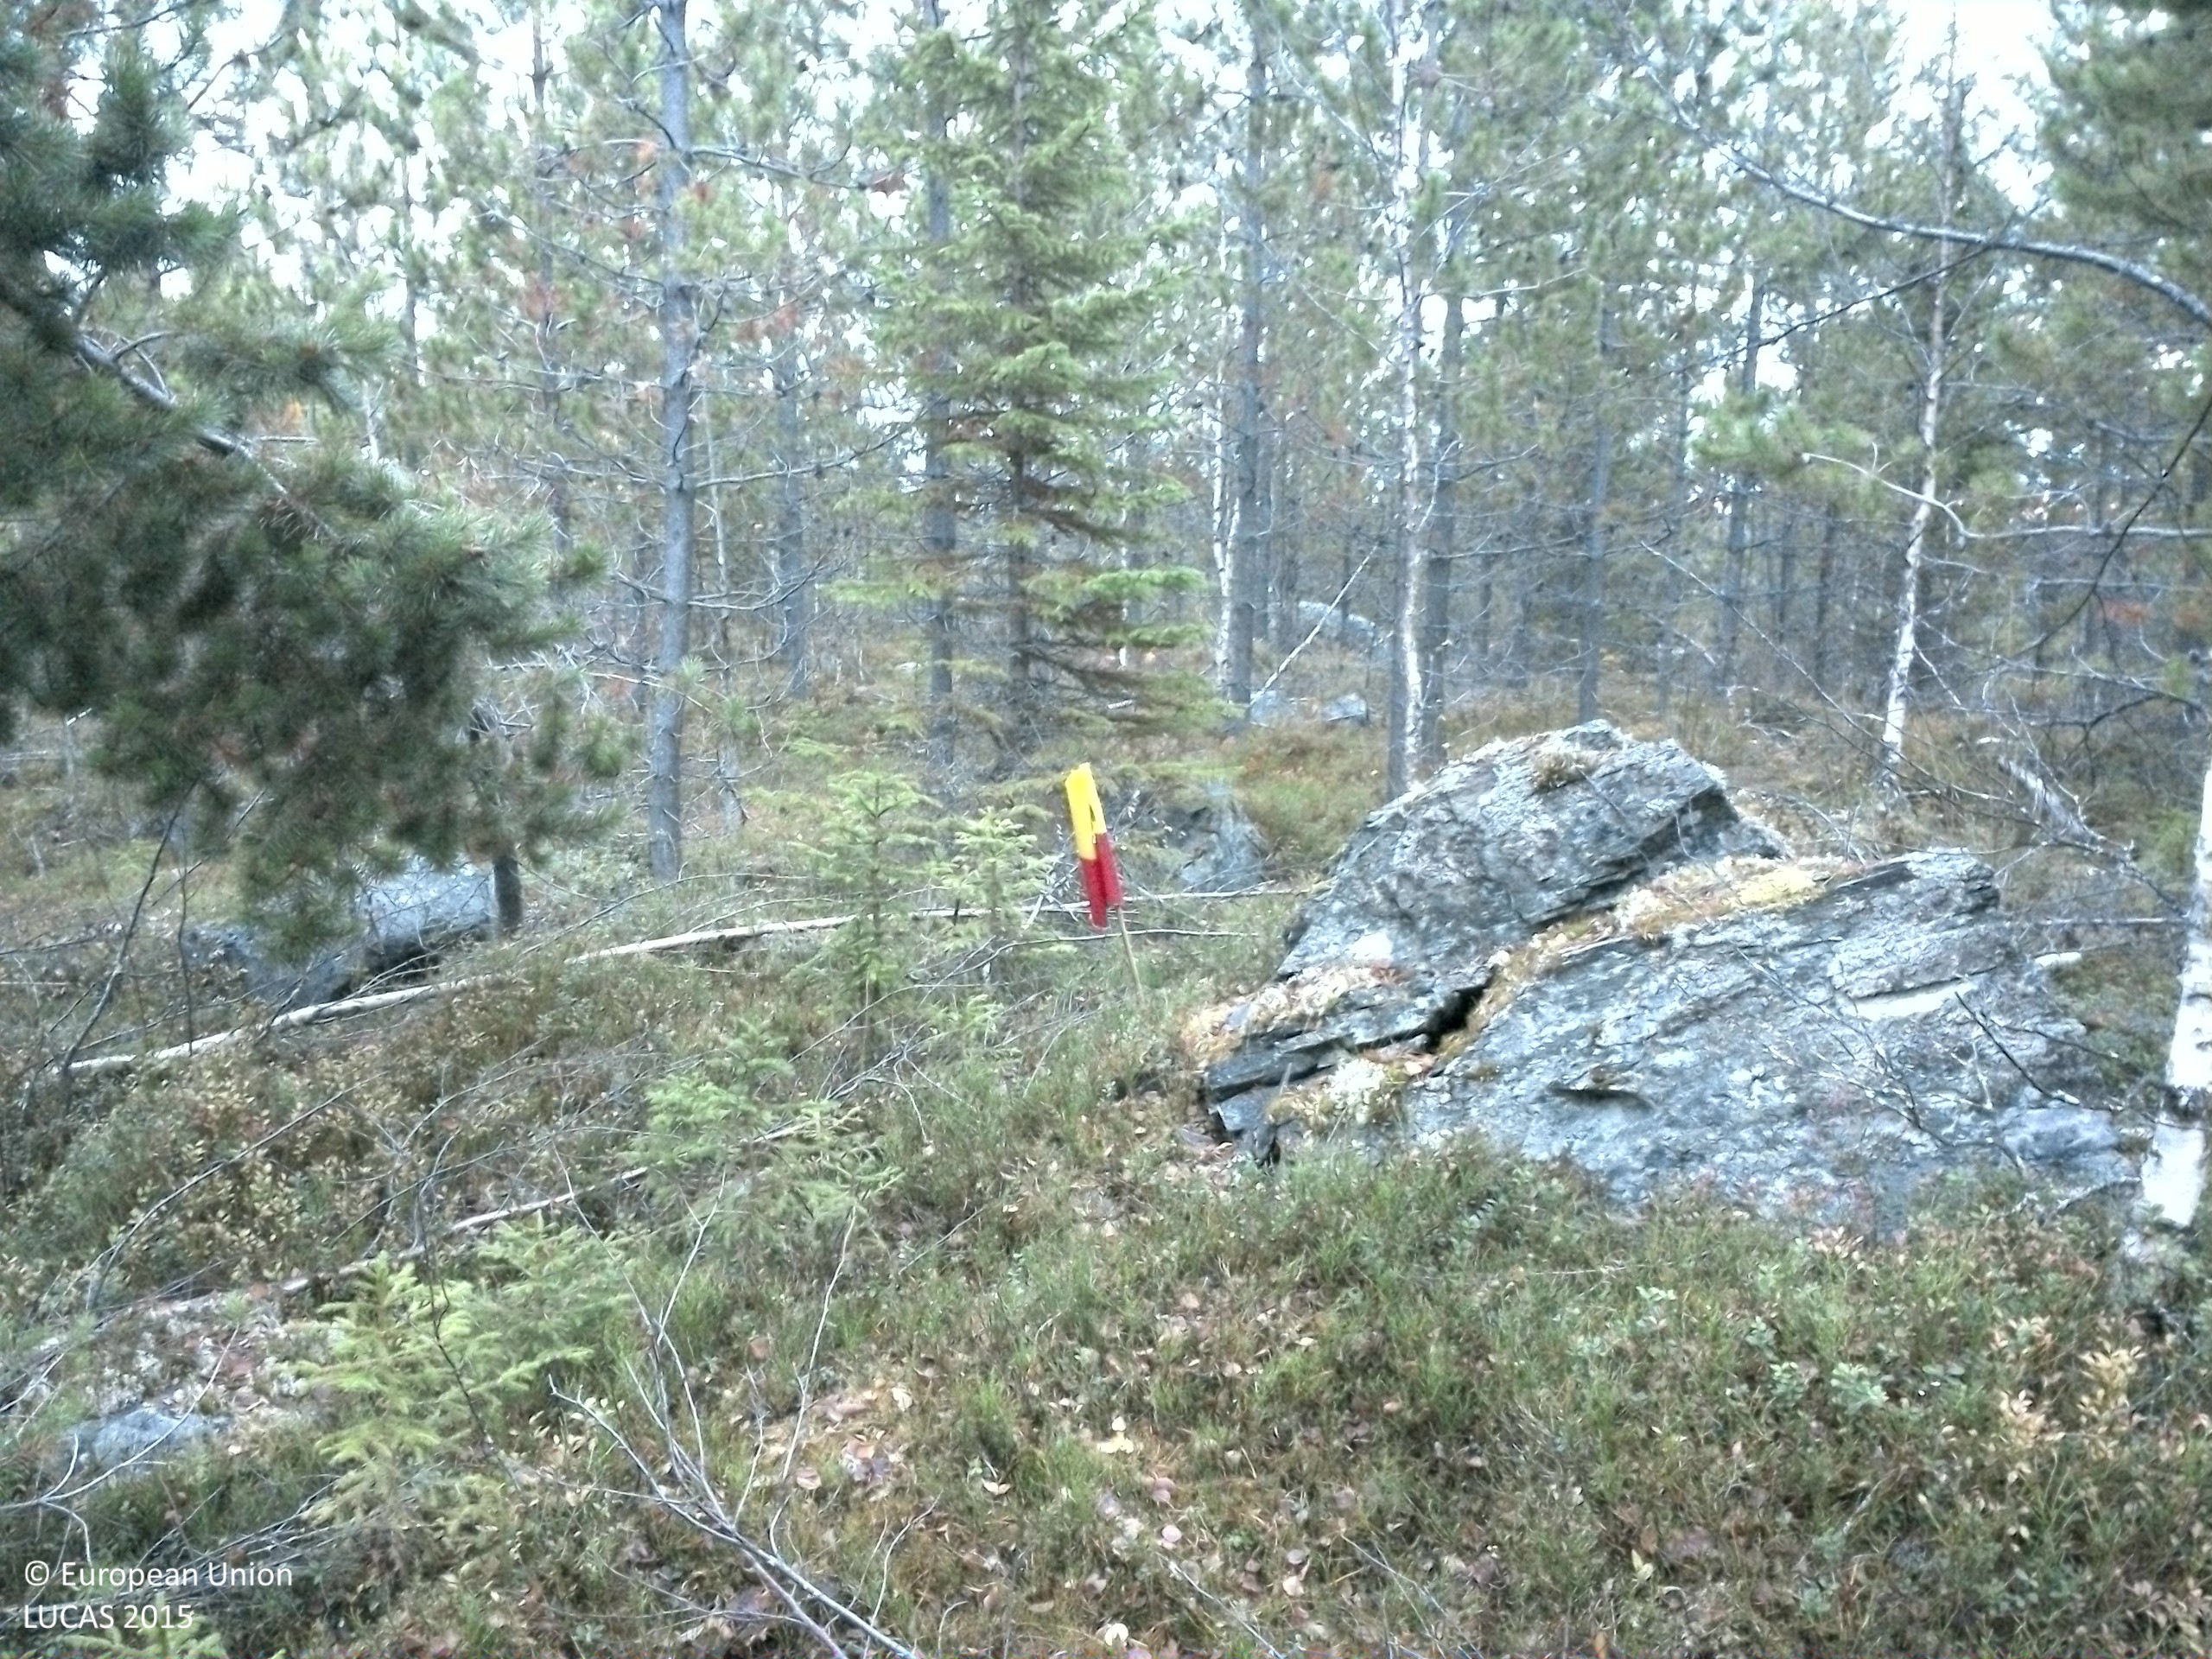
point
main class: Woodland
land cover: Pine dominated coniferous woodland
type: exotic forest
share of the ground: 50 - 75 %
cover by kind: coniferous forest trees 45 %, shrubs 30 %, lichens and mosses 15 %, broadleaved forest trees 5 %, consolidated bare surface 5 %
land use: Forestry
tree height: > 5 m
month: October
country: SE
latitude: 64.4290
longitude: 15.5146
